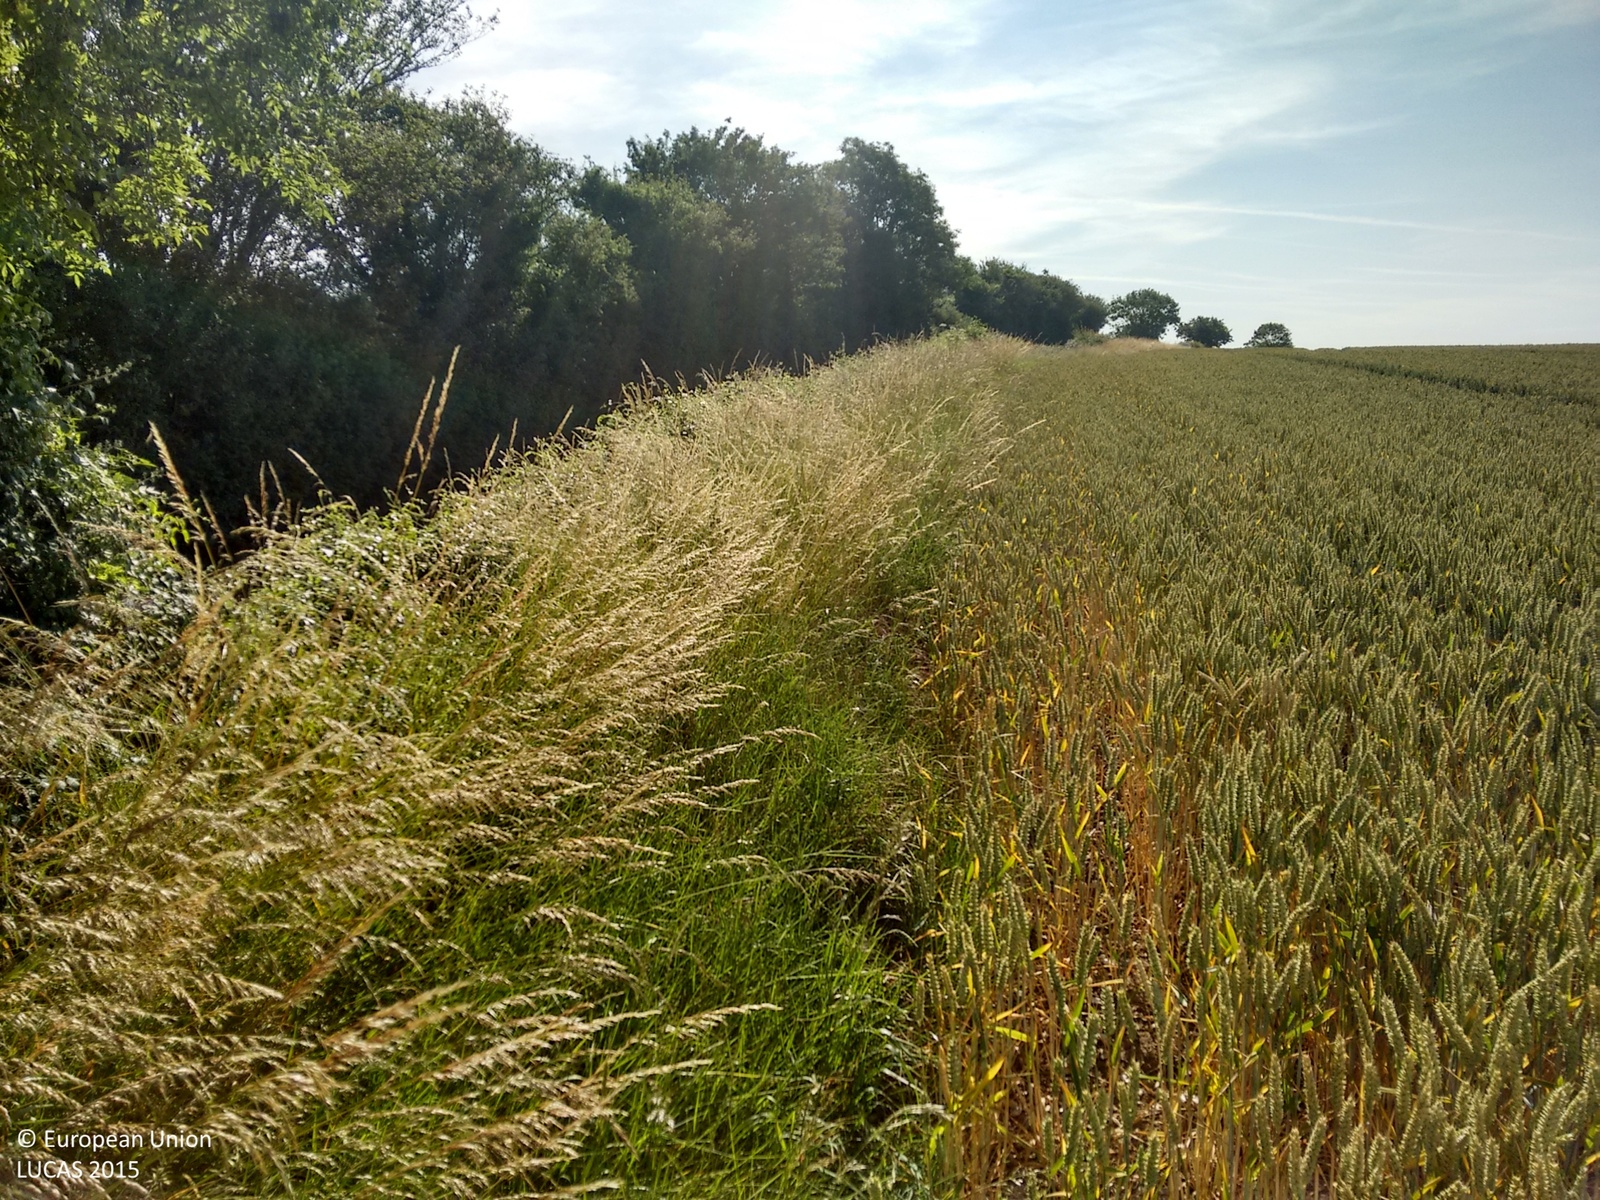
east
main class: Cropland
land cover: Common wheat
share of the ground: 50 - 75 %
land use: Agriculture (excluding fallow land and kitchen gardens)
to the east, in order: Common wheat; Shruby margins; Managed hedges; Paved roads, cycling and walking lanes; Managed hedges; Oats; Broadleaved woodland; Tracks; Broadleaved woodland; Shruby margins; Tracks; Common wheat
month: July
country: GB
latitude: 50.8771
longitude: -0.8867
